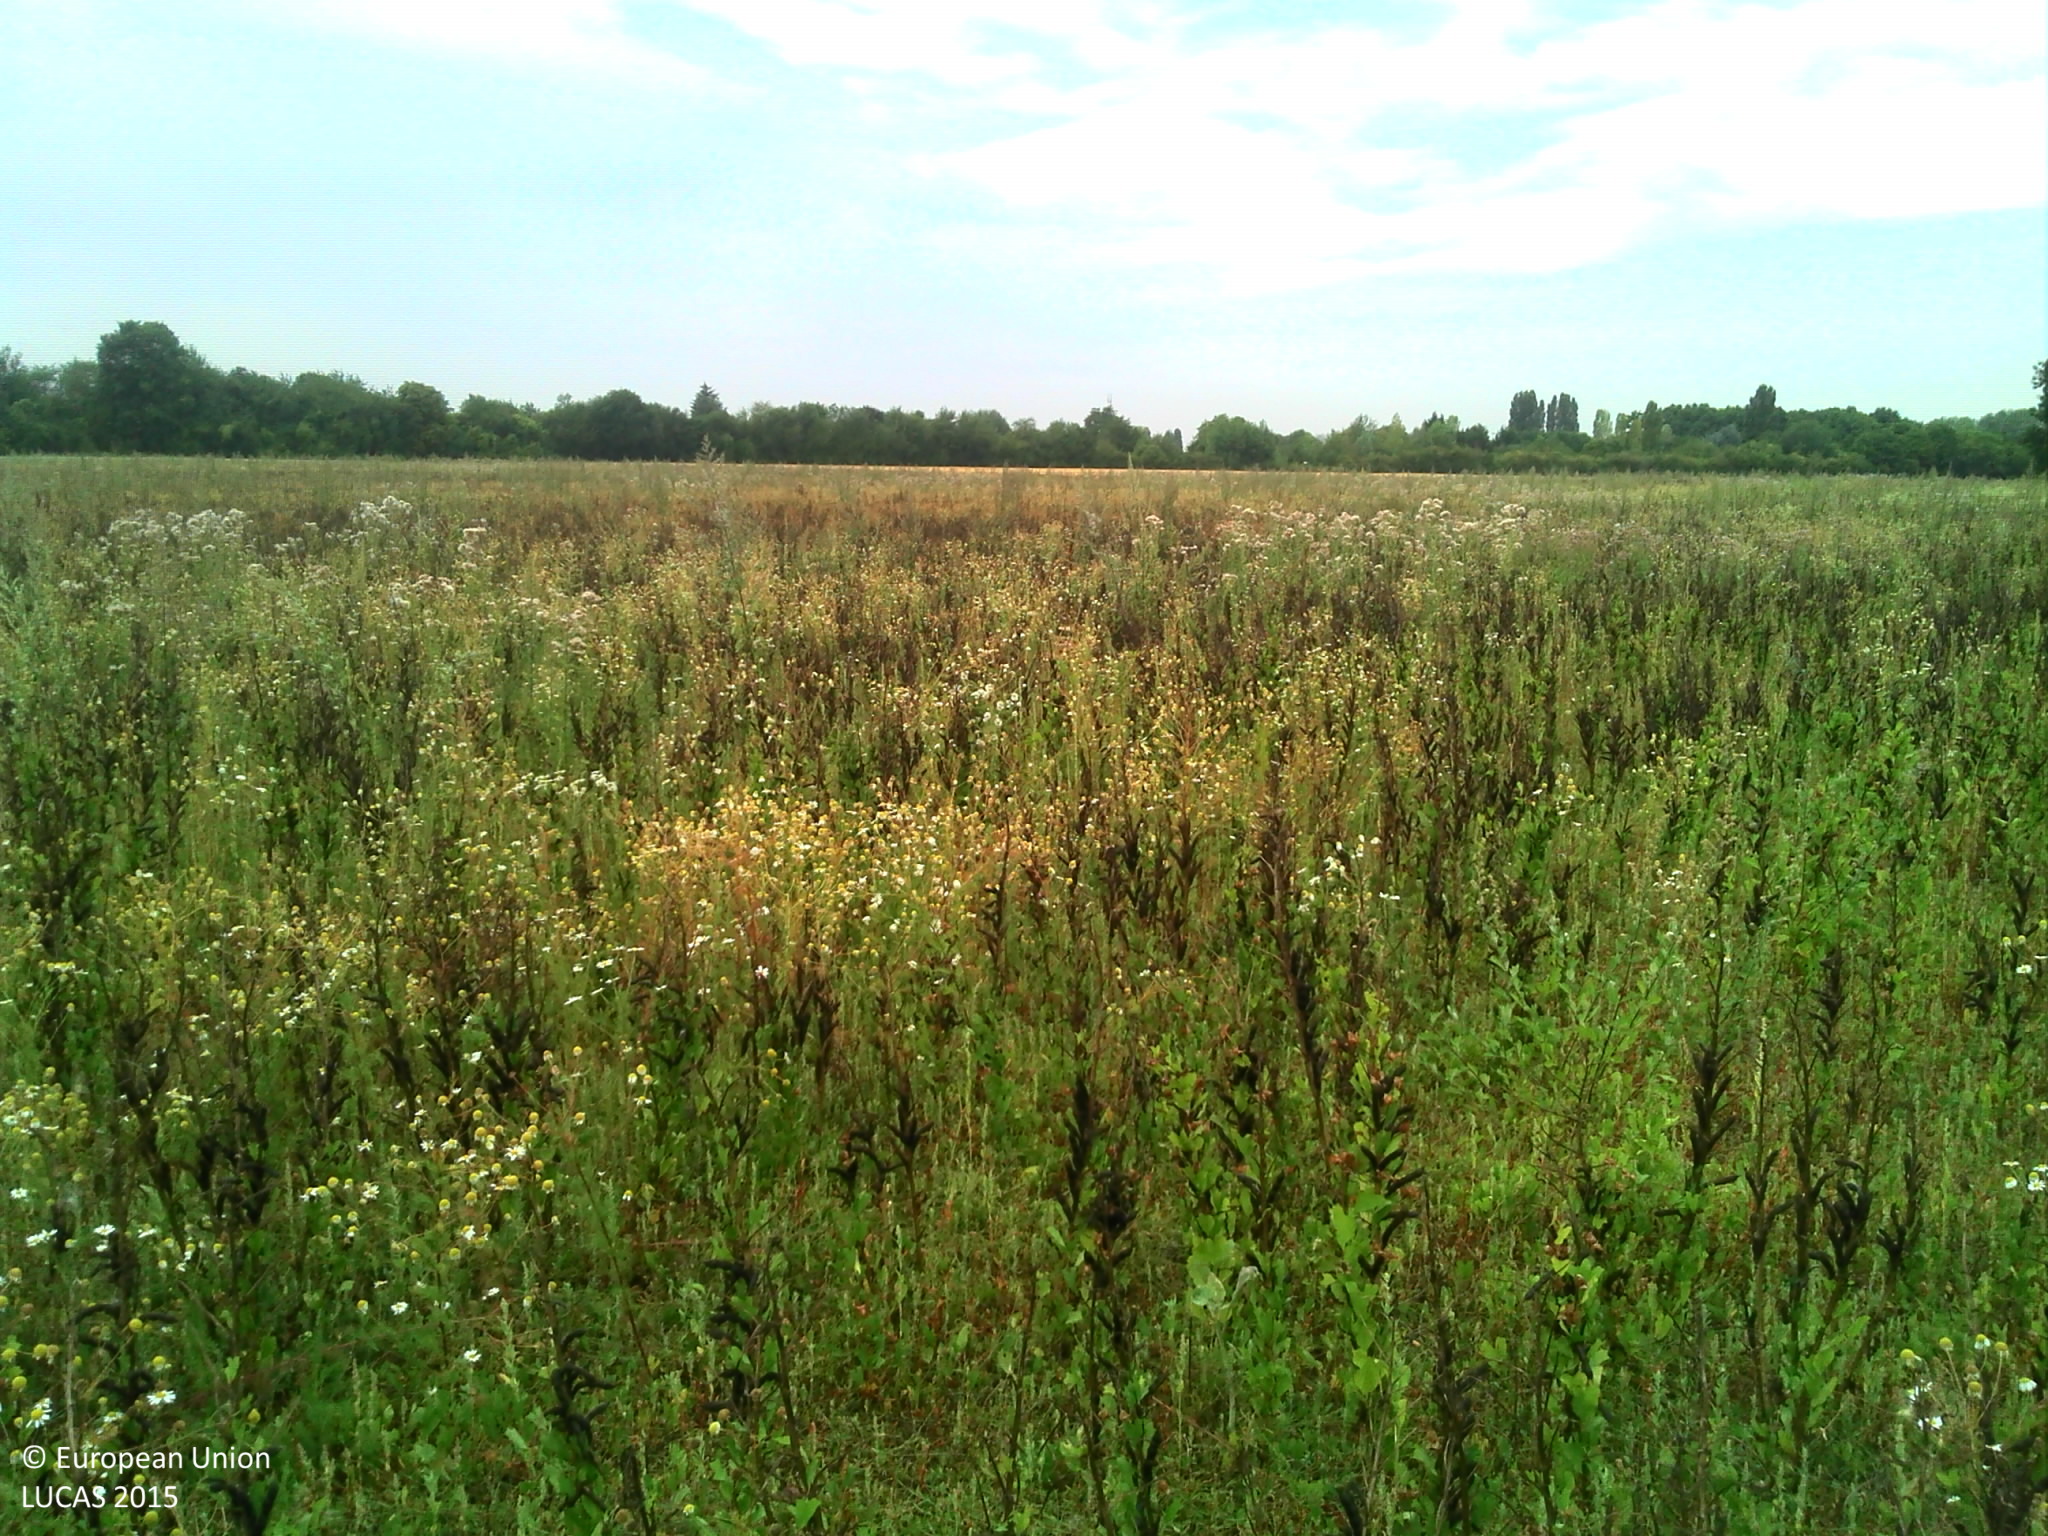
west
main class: Grassland
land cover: Spontaneously vegetated surfaces
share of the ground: > 75 %
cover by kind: herbaceous plants 100 %
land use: Fallow land
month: August
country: FR
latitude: 48.7124
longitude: 2.5552
